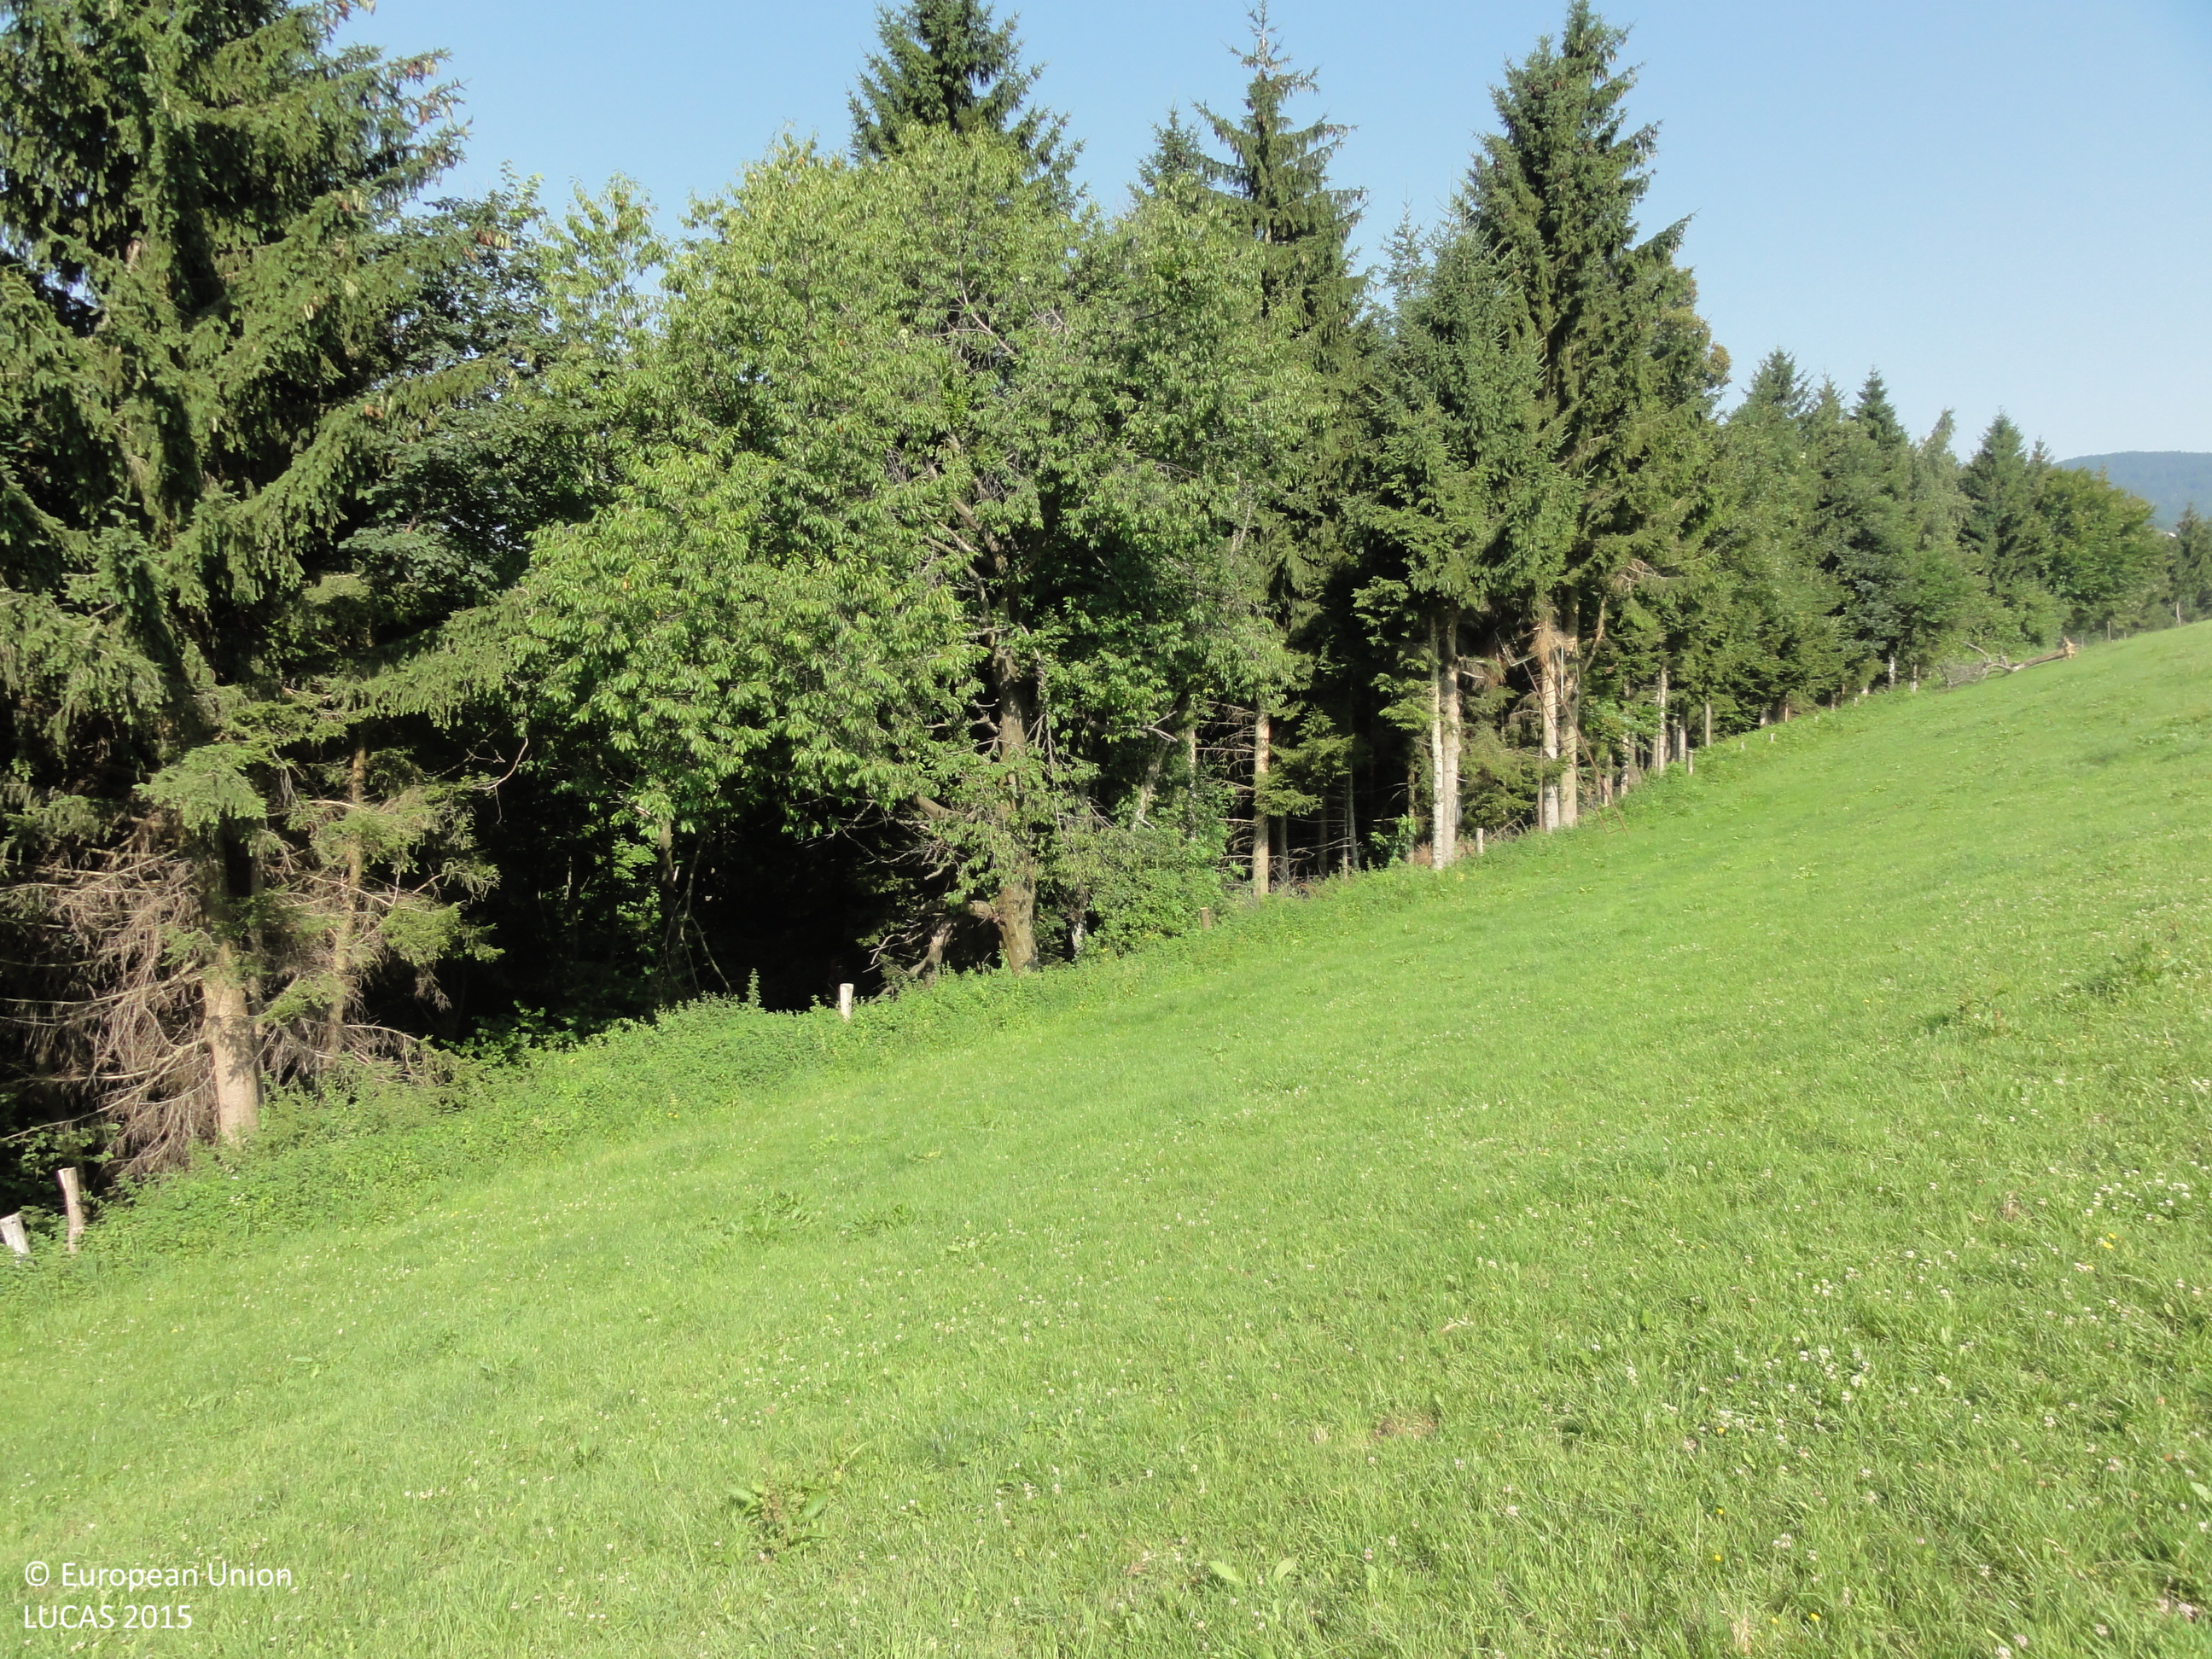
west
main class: Grassland
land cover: Grassland without tree/shrub cover
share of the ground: > 75 %
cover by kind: herbaceous plants 100 %
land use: Agriculture (excluding fallow land and kitchen gardens)
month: July
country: SI
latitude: 46.4608
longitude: 15.5325
